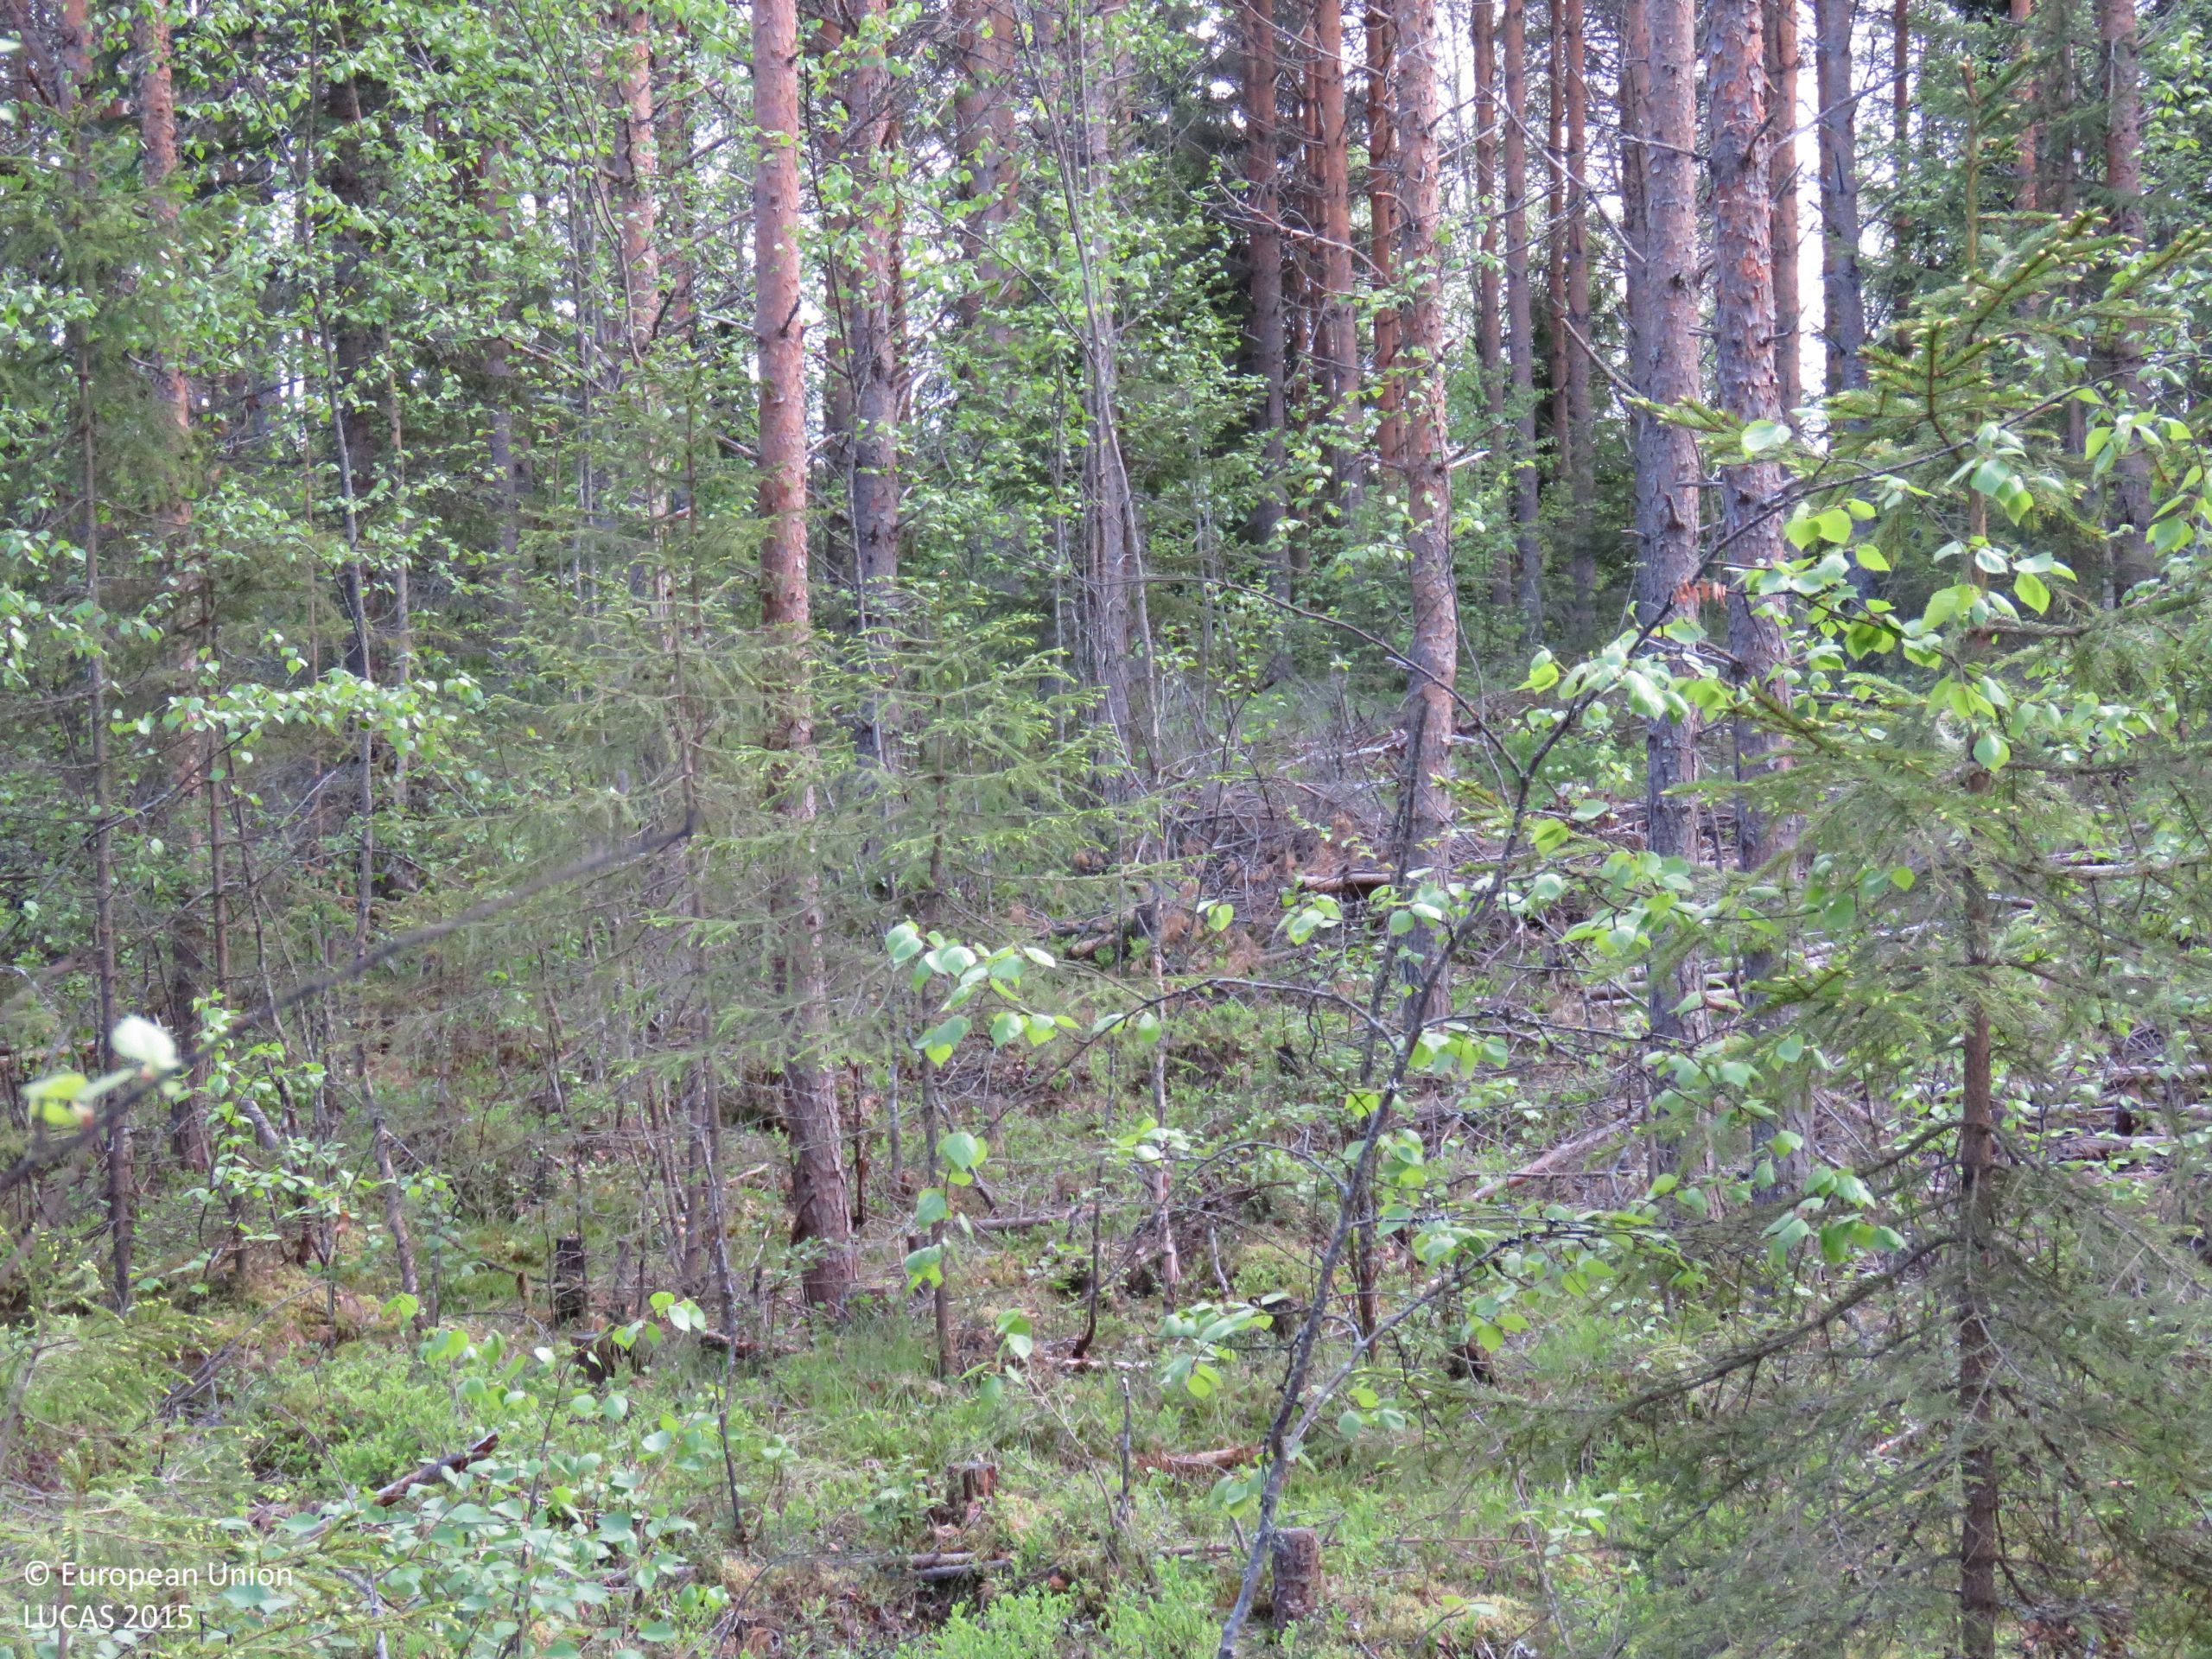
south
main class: Woodland
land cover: Other coniferous woodland
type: boreal forest
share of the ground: 50 - 75 %
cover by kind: coniferous forest trees 60 %, shrubs 30 %, broadleaved forest trees 5 %, lichens and mosses 5 %
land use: Forestry
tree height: > 5 m
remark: Clear cut
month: June
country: FI
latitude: 65.0524
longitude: 25.7053
